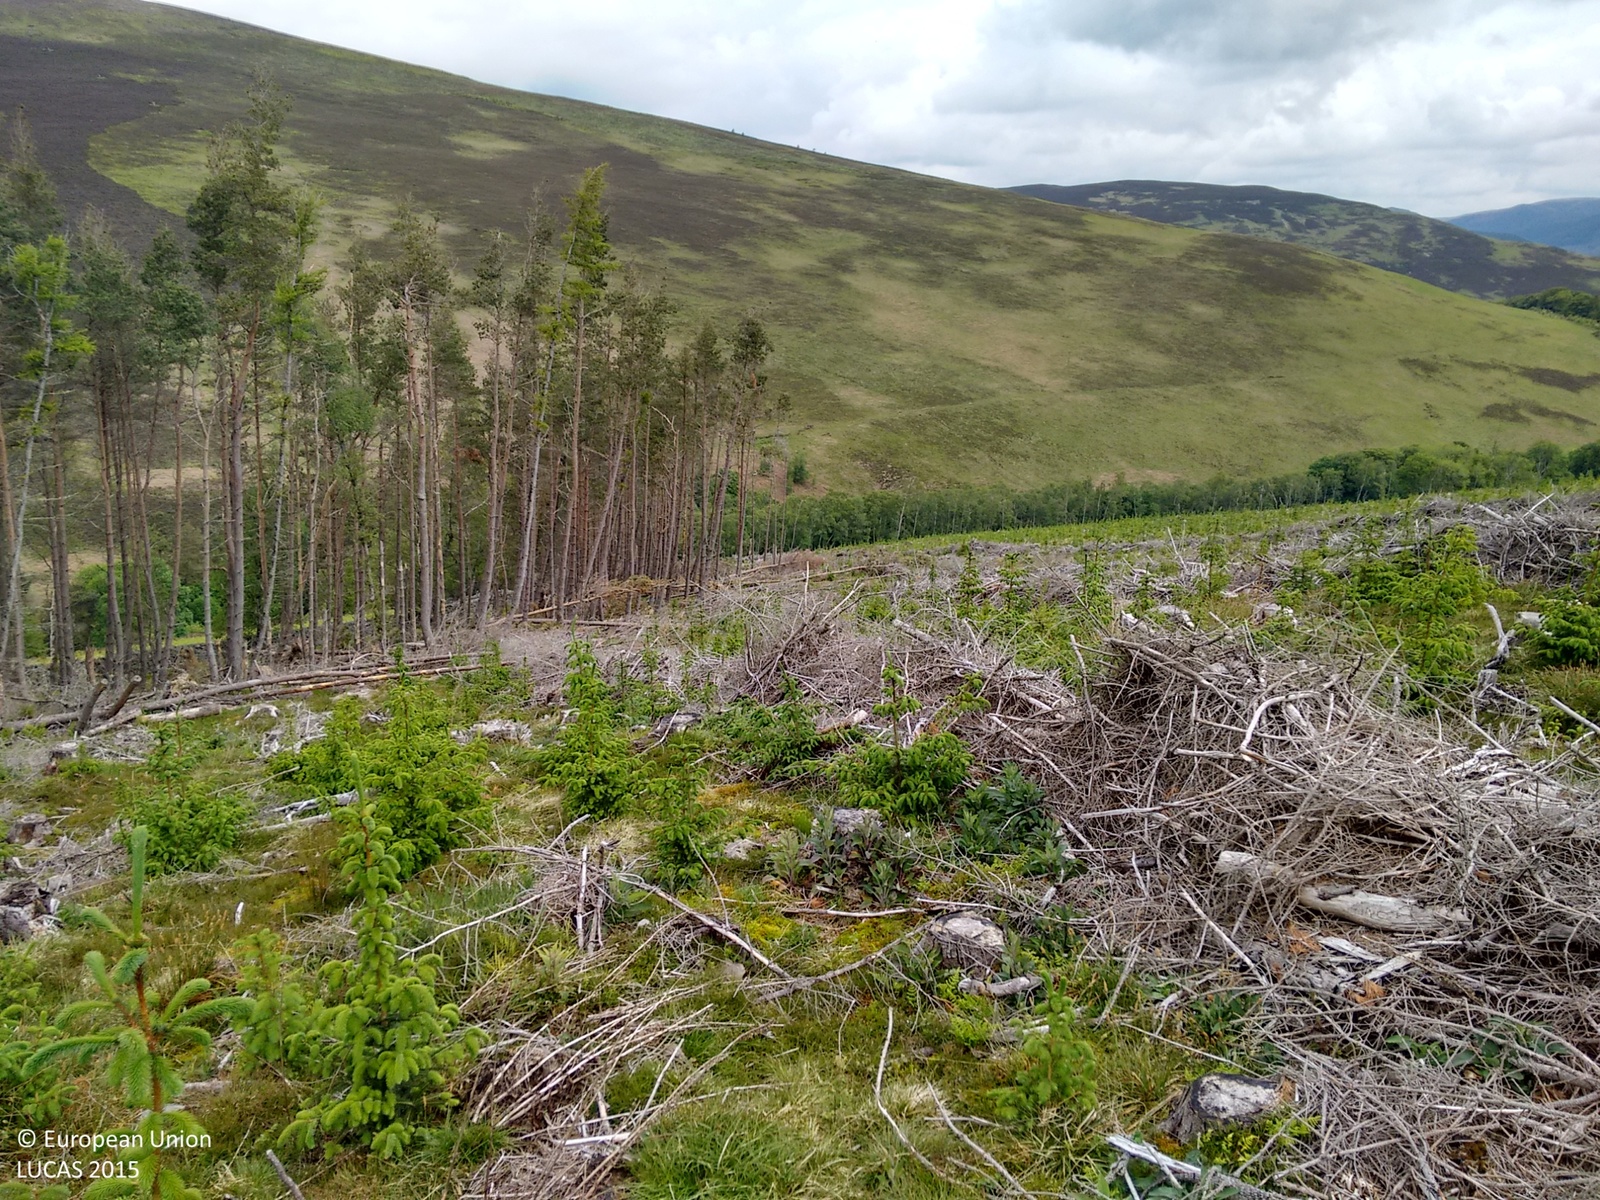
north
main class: Woodland
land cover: Spruce dominated coniferous woodland
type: exotic forest
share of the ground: < 10 %
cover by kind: herbaceous plants 60 %, coniferous forest trees 10 %, shrubs 10 %, lichens and mosses 10 %
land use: Forestry
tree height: < 5 m
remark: Clear cut
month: June
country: GB
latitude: 55.5825
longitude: -3.1277
